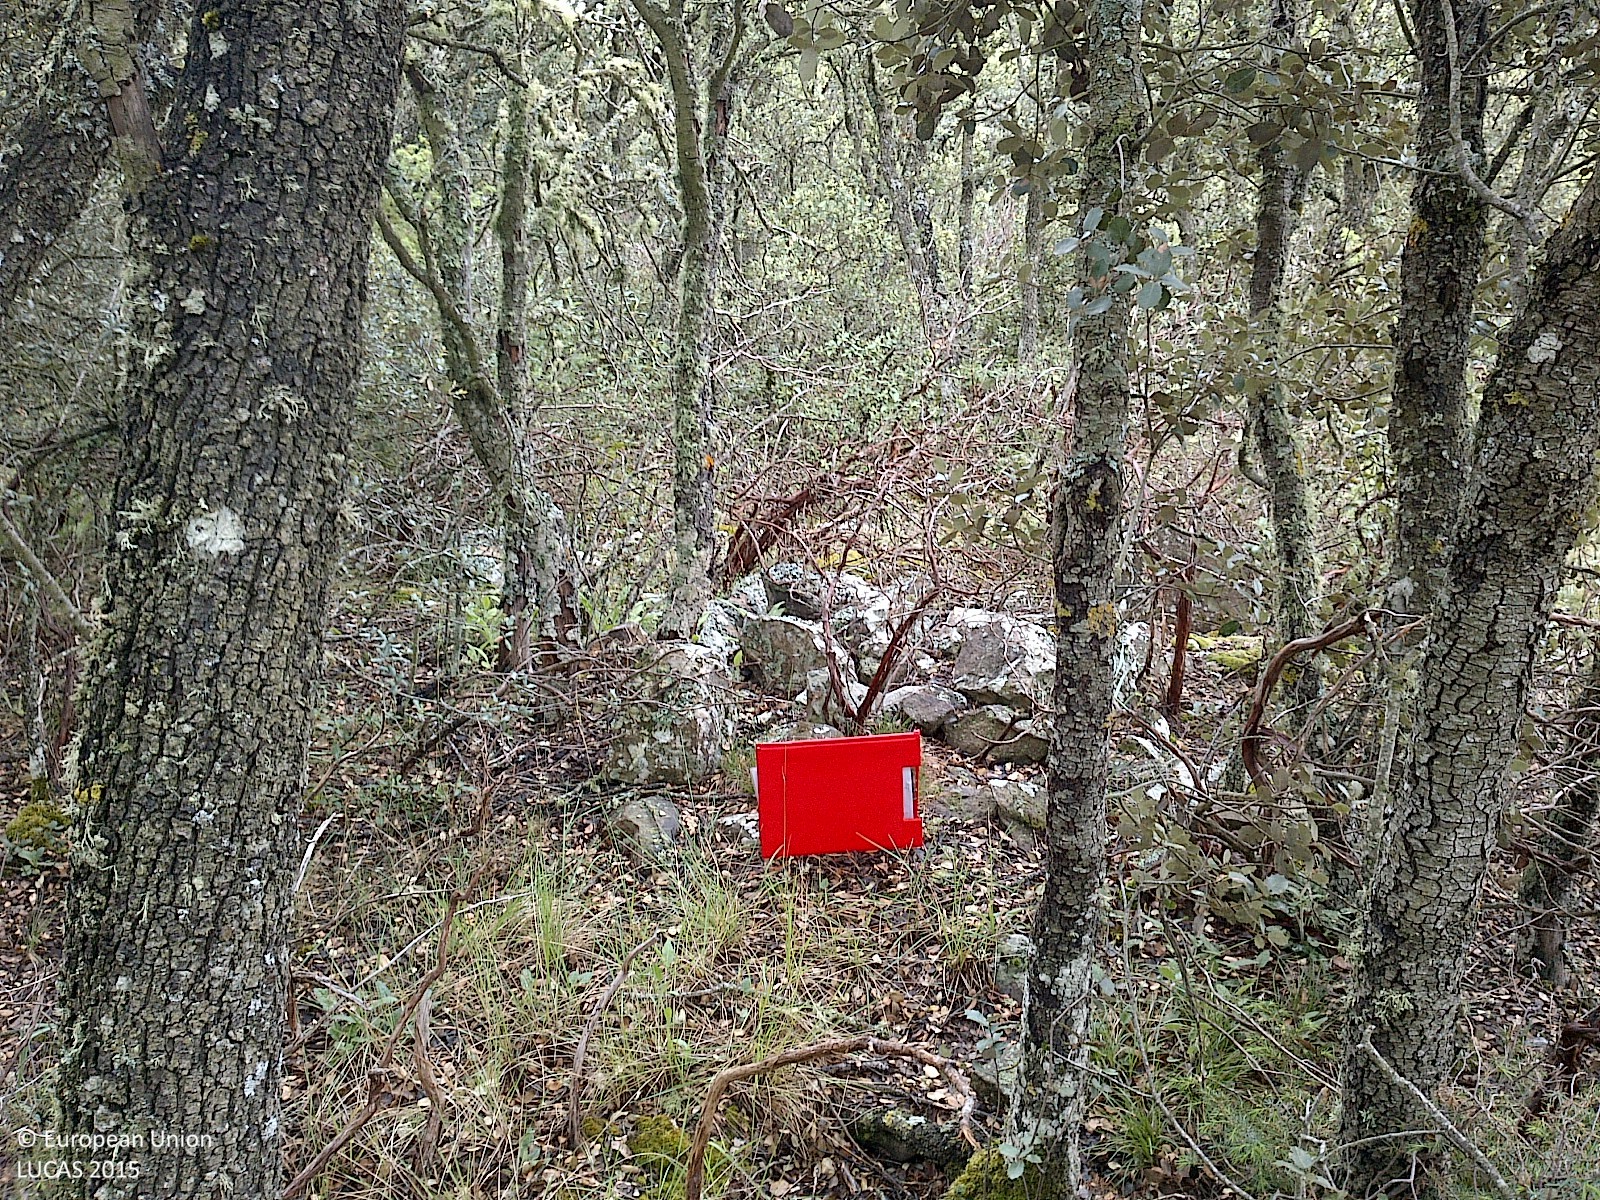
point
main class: Woodland
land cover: Broadleaved woodland
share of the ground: 50 - 75 %
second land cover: Shrubland without tree cover
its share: 25 - 50 %
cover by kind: broadleaved forest trees 55 %, shrubs 30 %, herbaceous plants 10 %, consolidated bare surface 5 %
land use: Forestry
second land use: Agriculture (excluding fallow land and kitchen gardens)
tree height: < 5 m
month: May
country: ES
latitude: 41.8007
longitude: -2.2274
